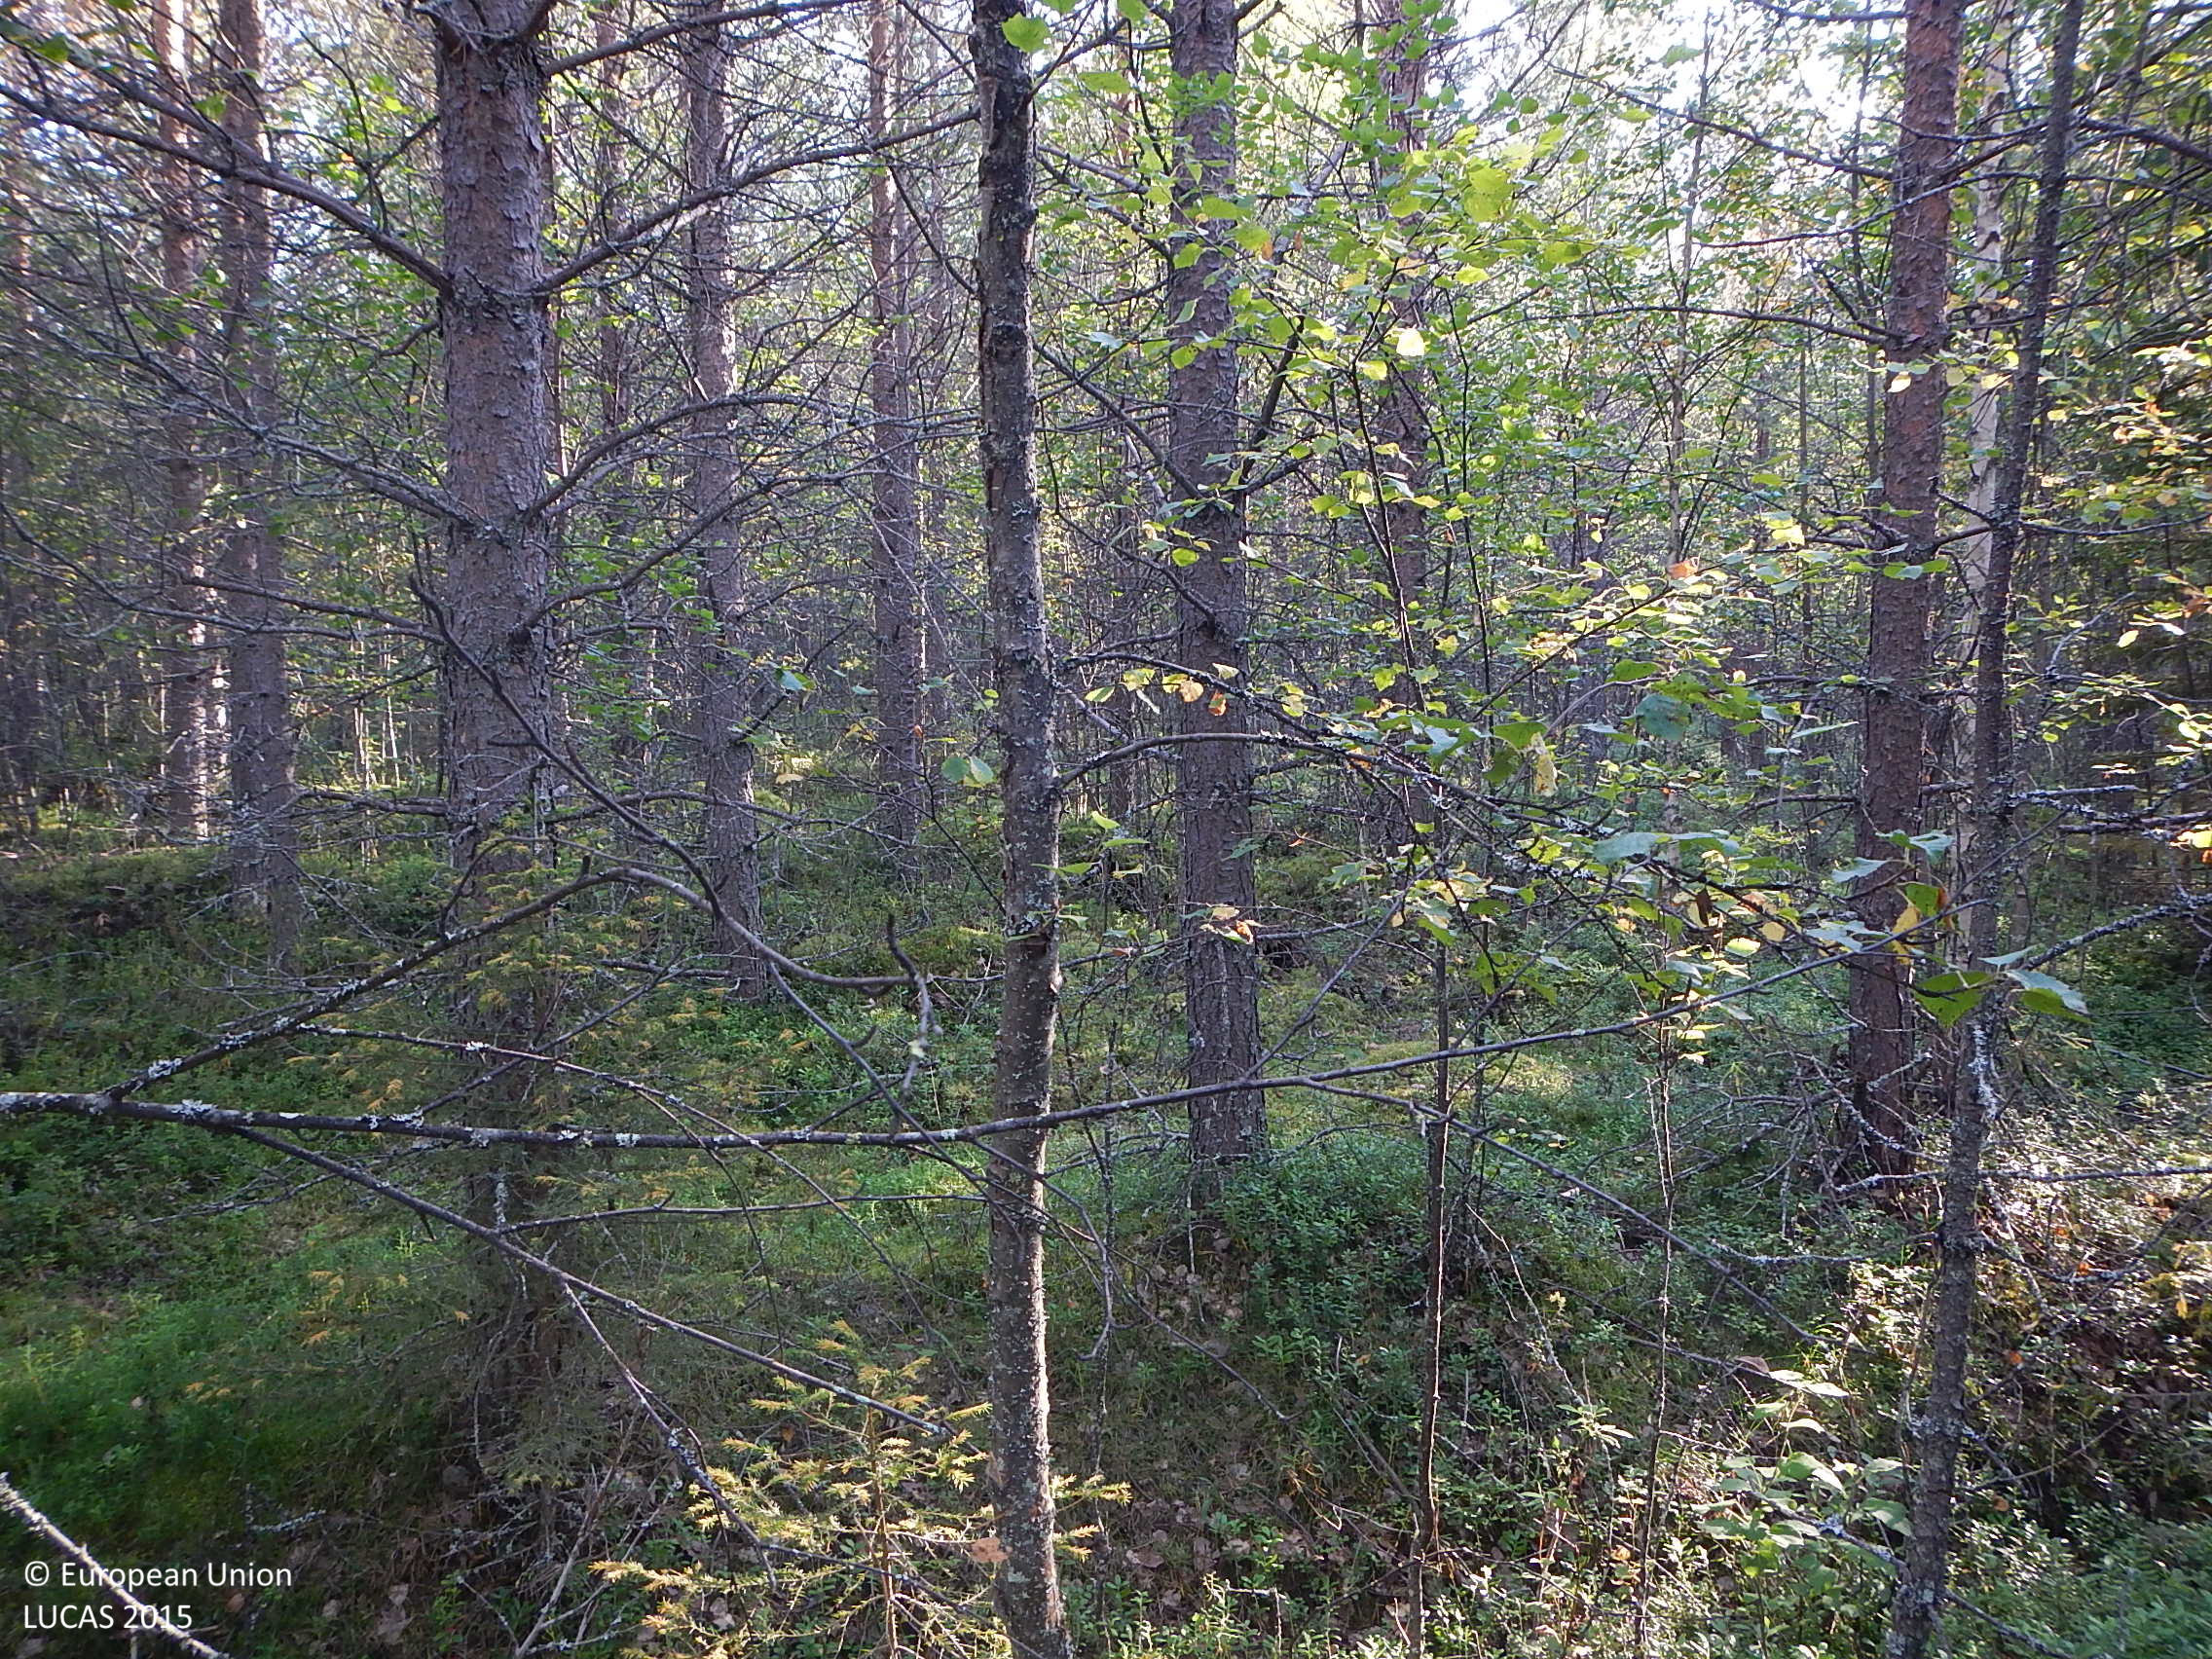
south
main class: Woodland
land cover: Pine dominated mixed woodland
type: boreal forest
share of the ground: > 75 %
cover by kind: coniferous forest trees 60 %, broadleaved forest trees 20 %, shrubs 10 %, herbaceous plants 5 %, lichens and mosses 5 %
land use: Forestry
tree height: > 5 m
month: August
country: FI
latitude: 66.4029
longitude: 28.2963
